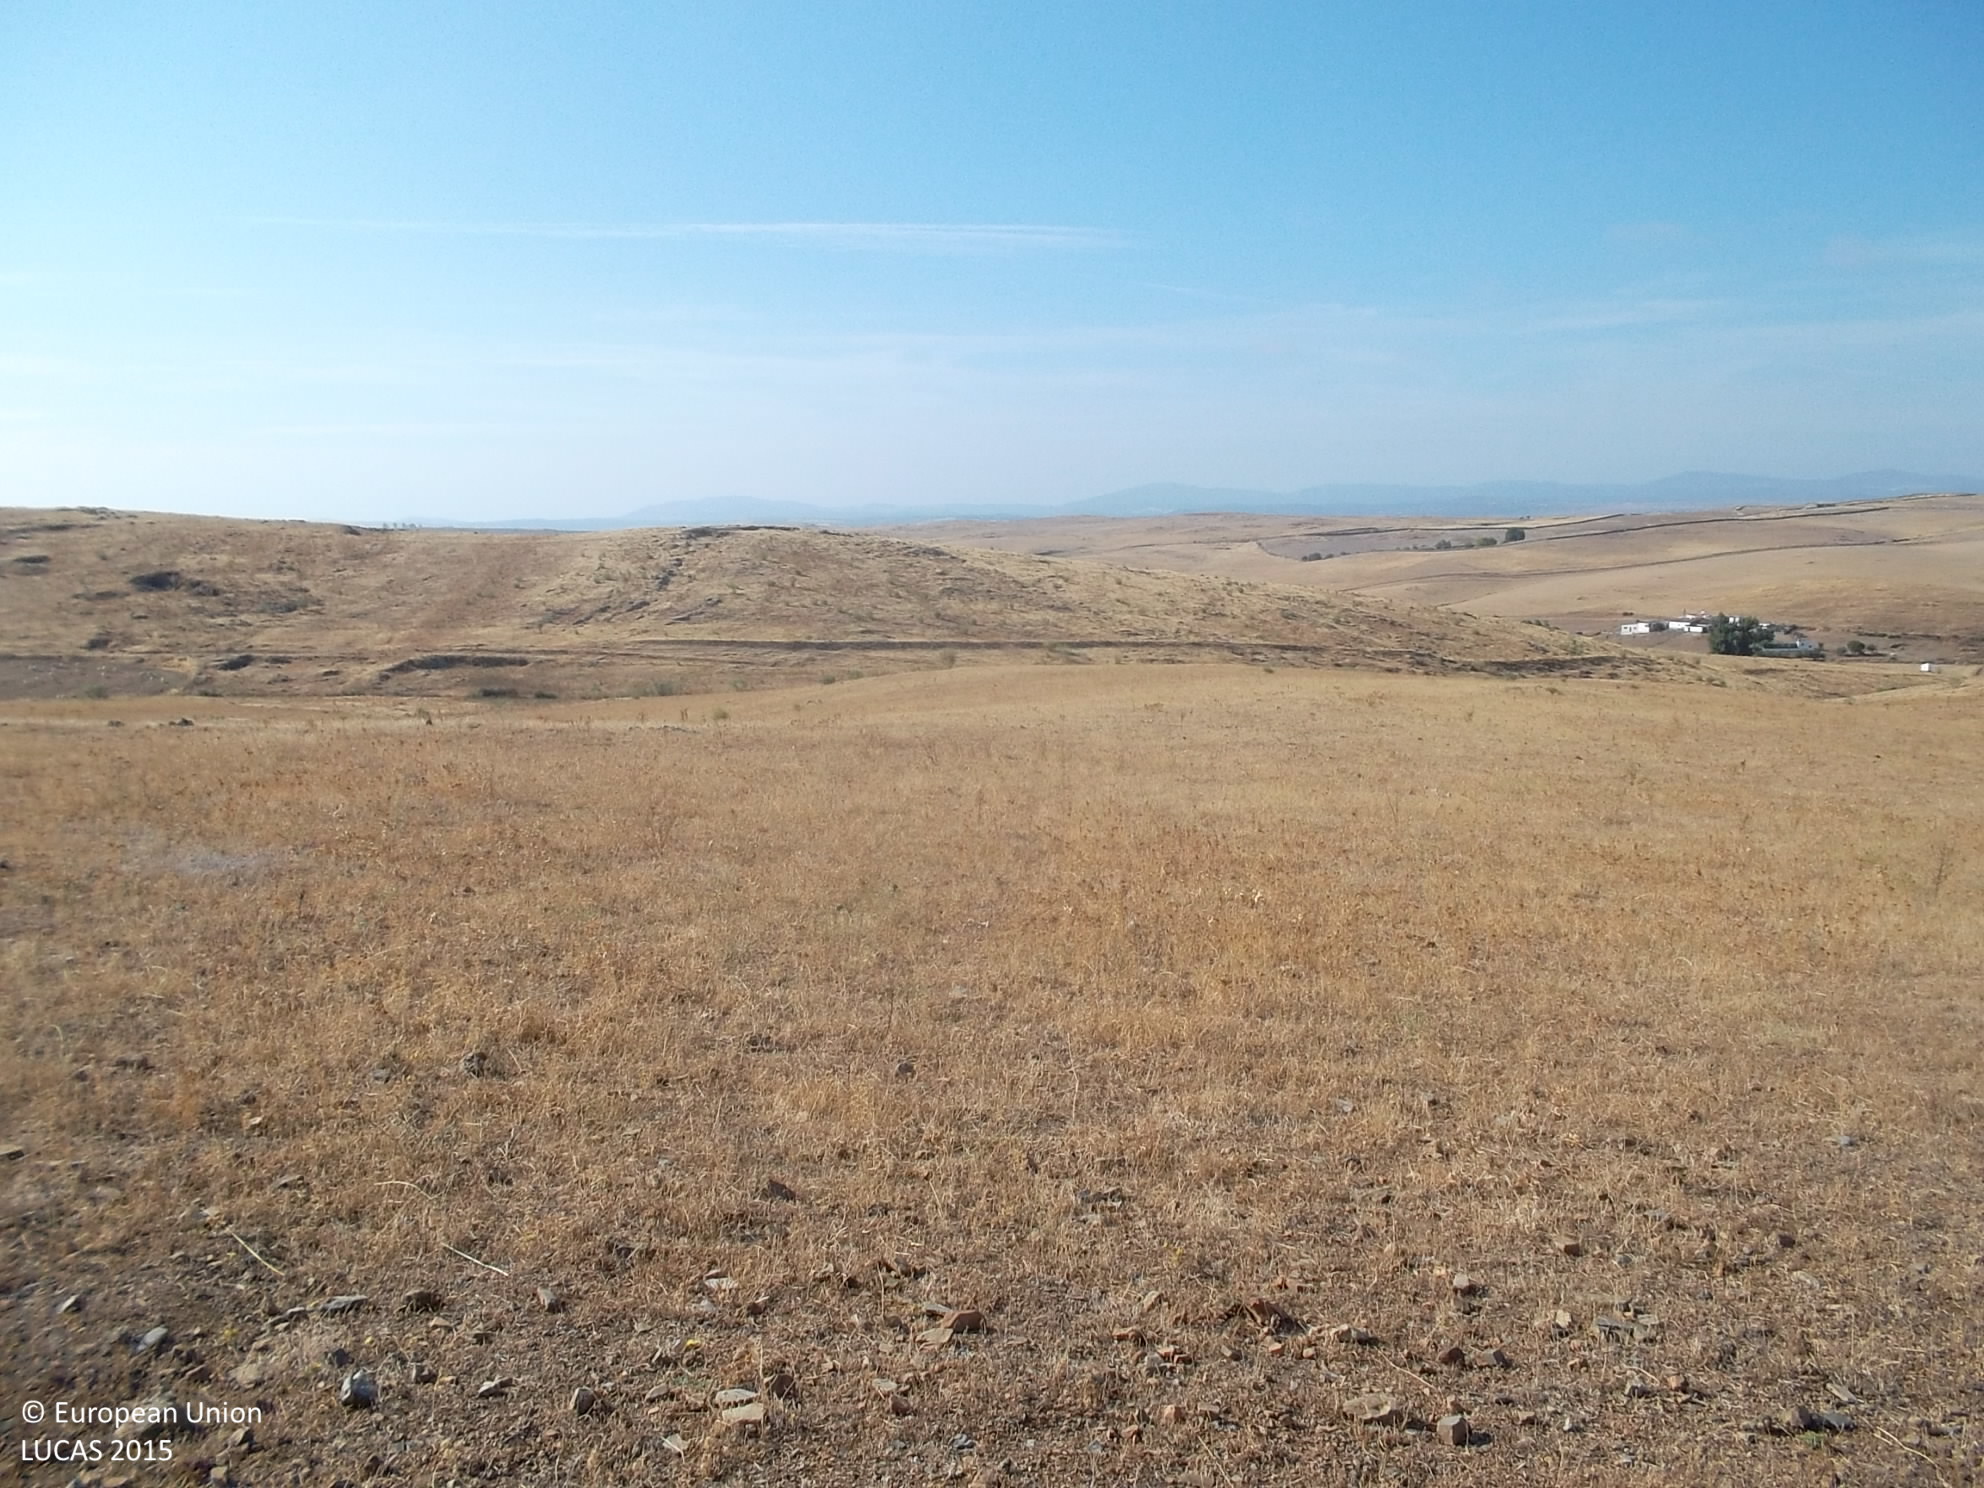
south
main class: Grassland
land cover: Spontaneously vegetated surfaces
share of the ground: > 75 %
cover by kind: herbaceous plants 100 %
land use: Fallow land
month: September
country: ES
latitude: 38.2442
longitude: -6.3275
